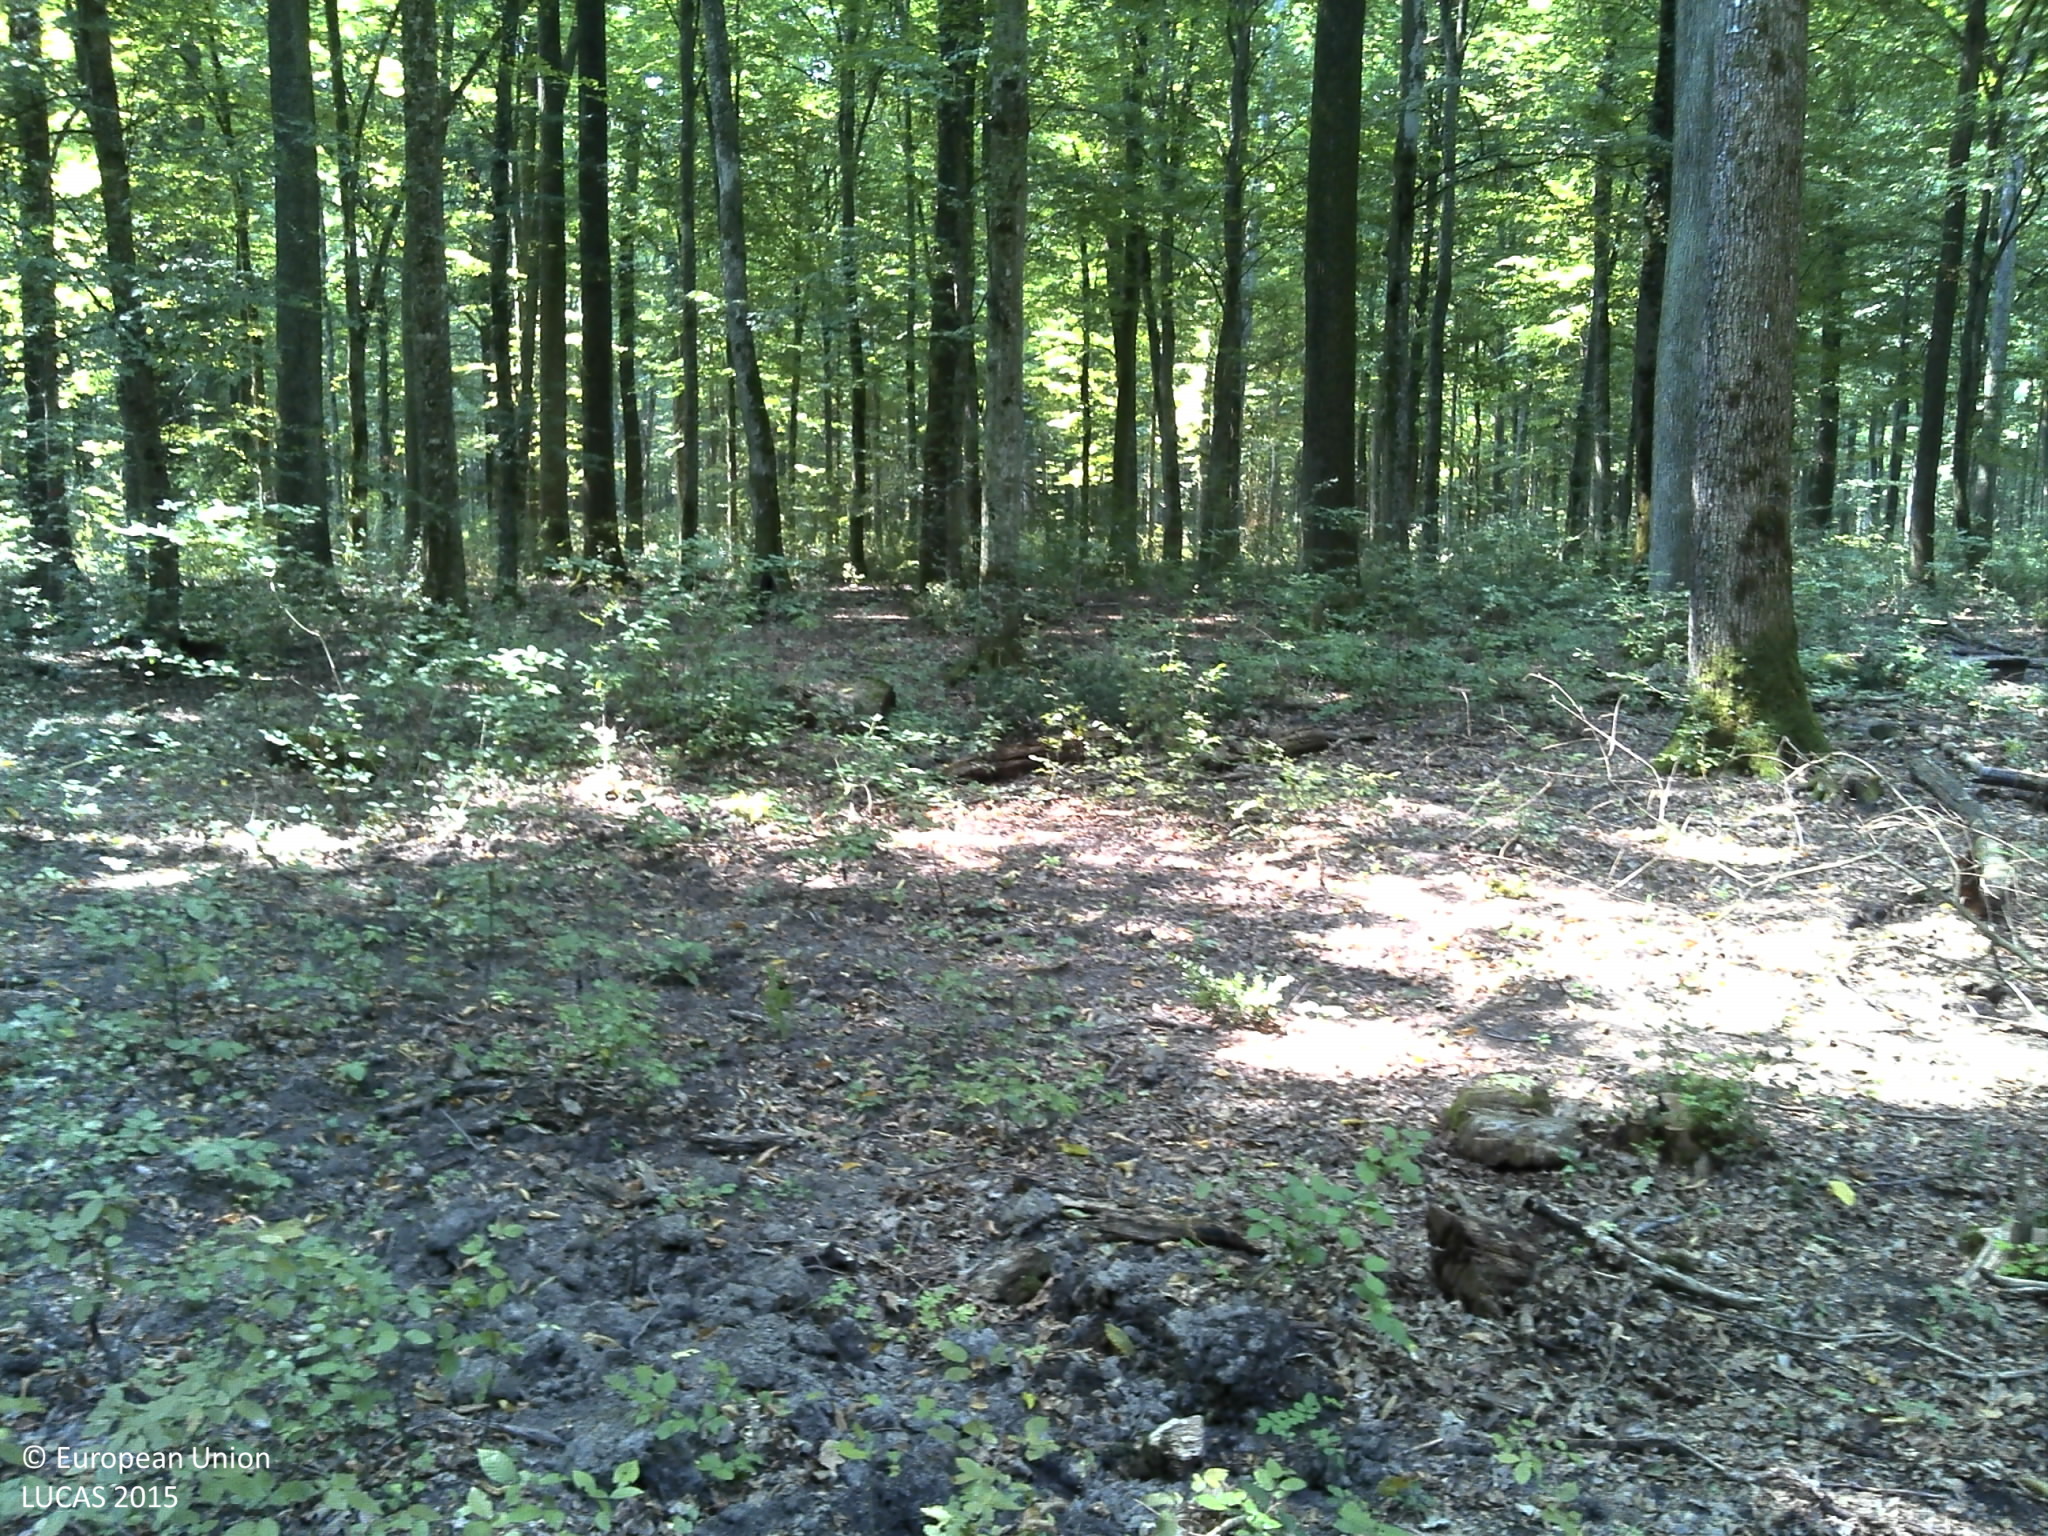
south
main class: Woodland
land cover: Broadleaved woodland
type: acidophilous oak and oak-birch forest
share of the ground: > 75 %
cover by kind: broadleaved forest trees 100 %
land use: Forestry
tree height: > 5 m
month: August
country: HR
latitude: 45.1169
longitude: 18.8158
